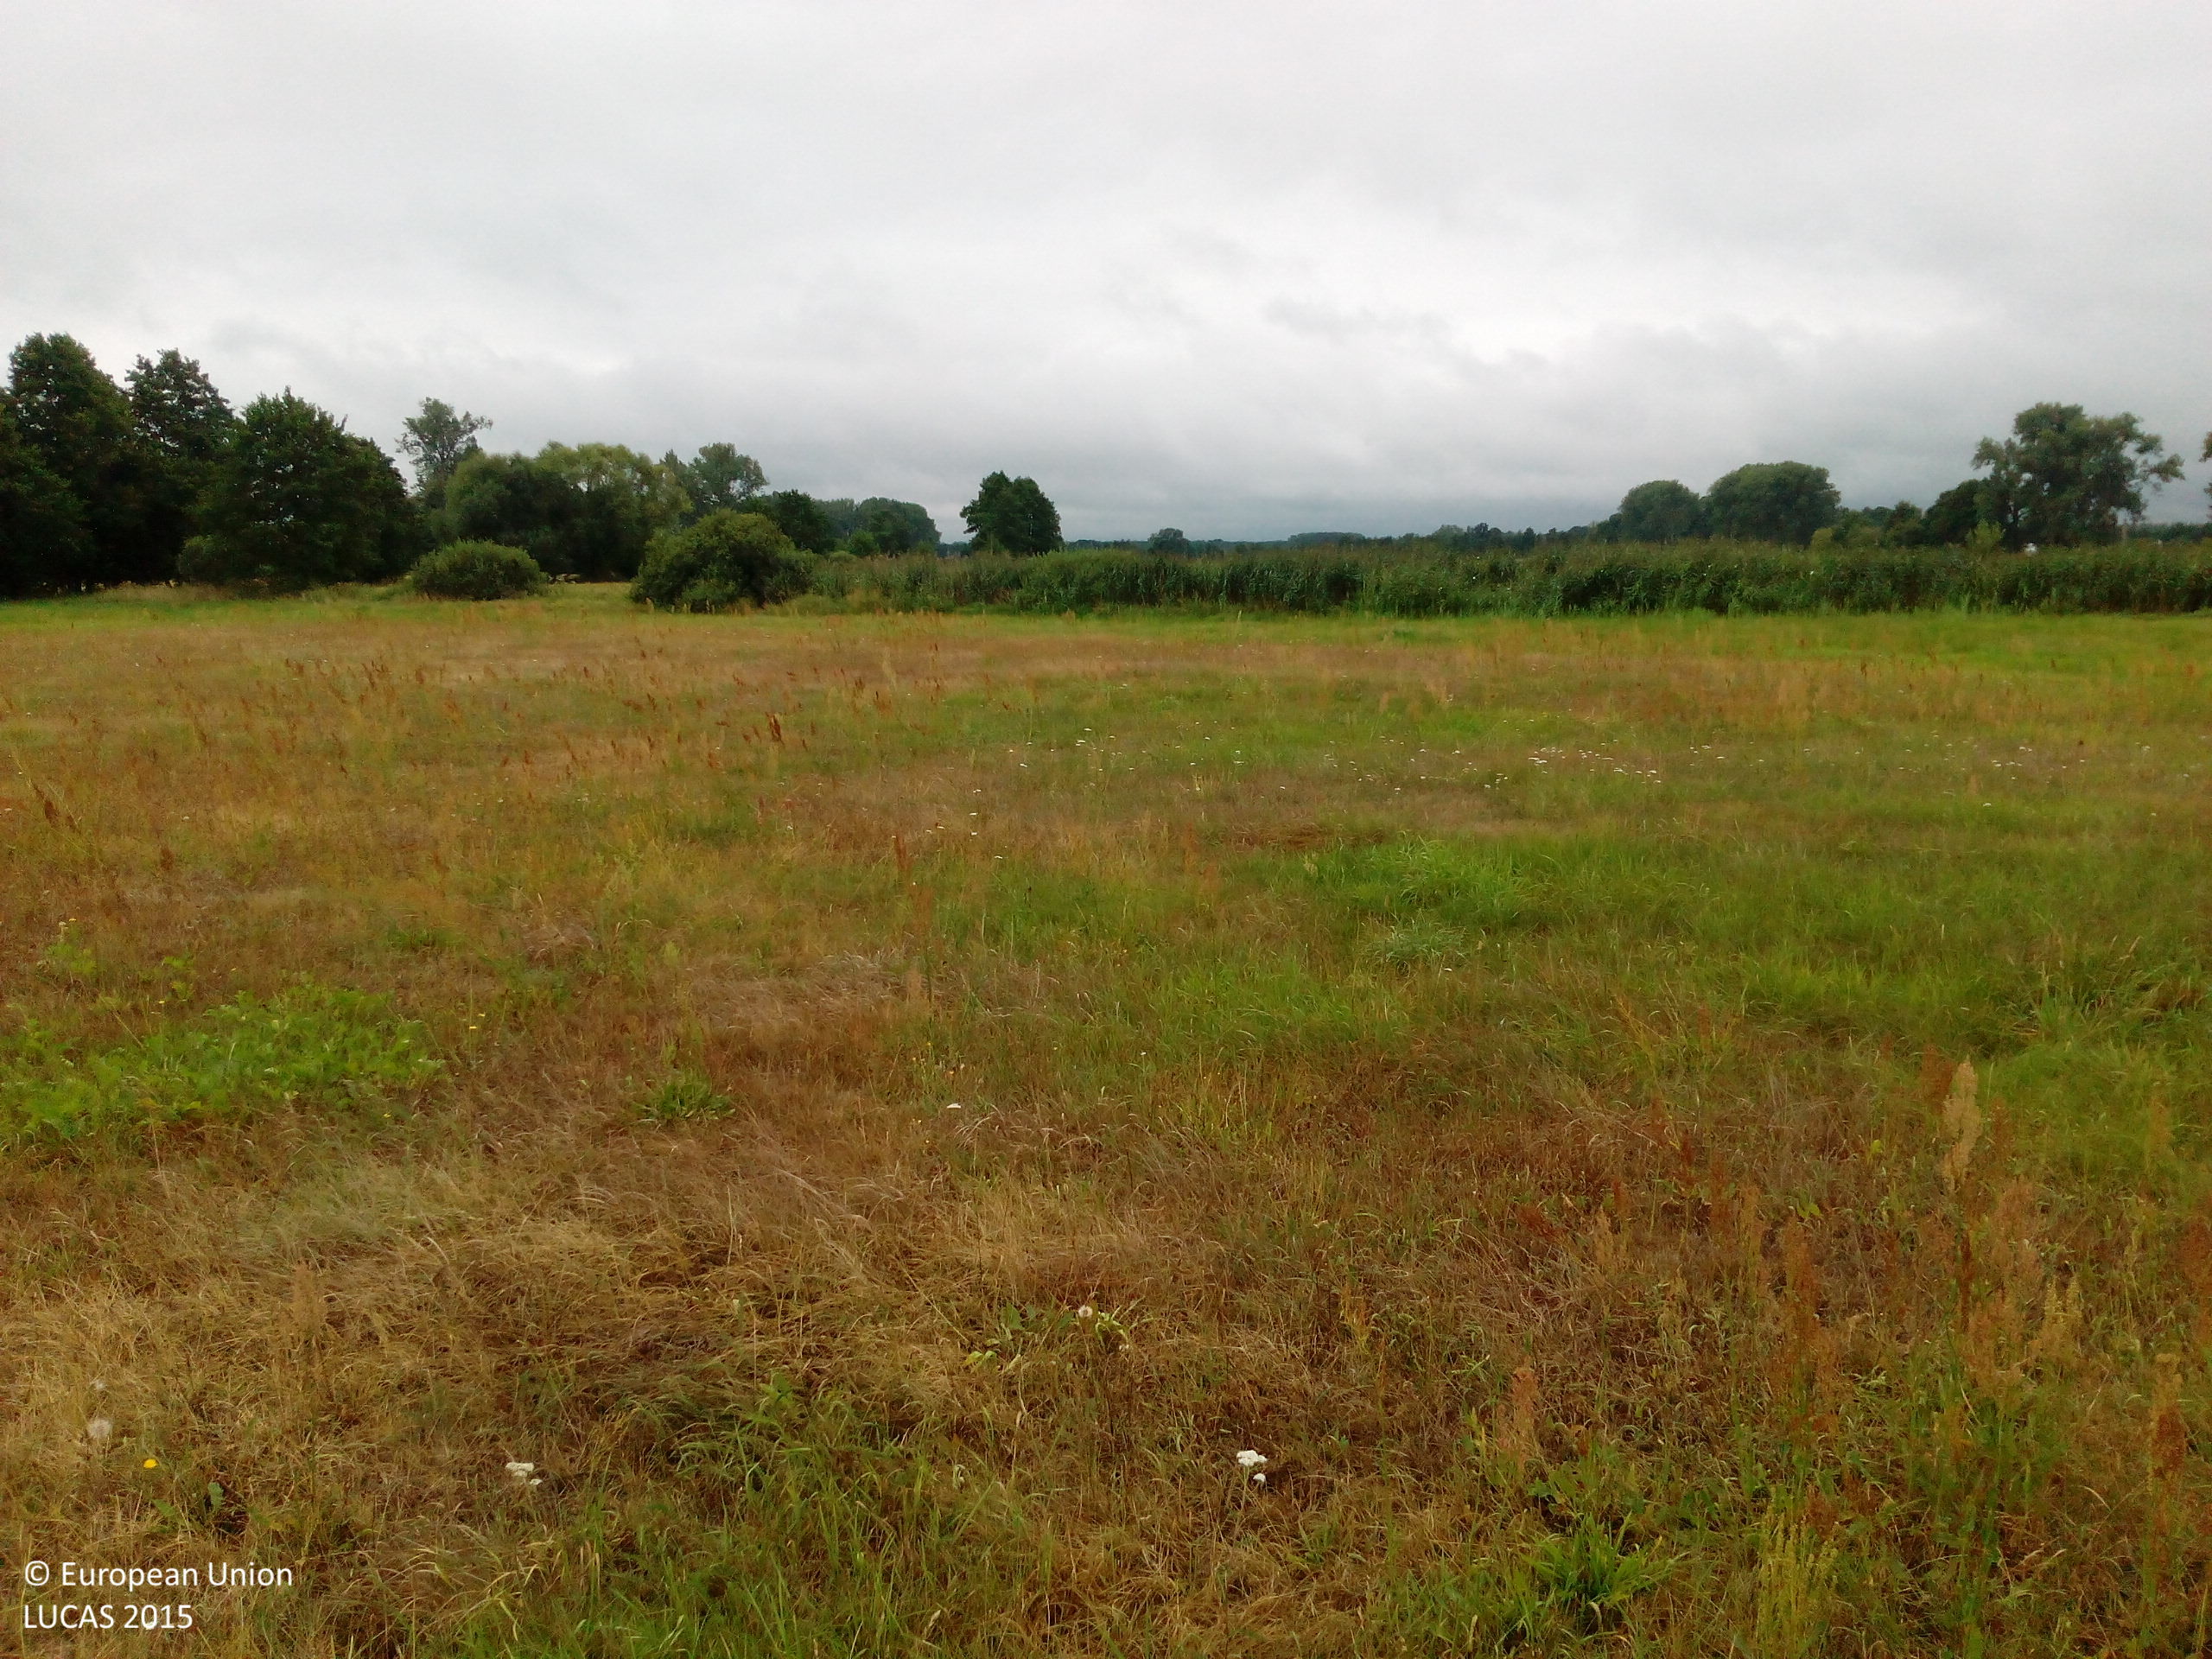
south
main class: Grassland
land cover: Grassland without tree/shrub cover
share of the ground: > 75 %
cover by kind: herbaceous plants 100 %
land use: Agriculture (excluding fallow land and kitchen gardens)
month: August
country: DE
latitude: 51.9112
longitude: 14.0860
